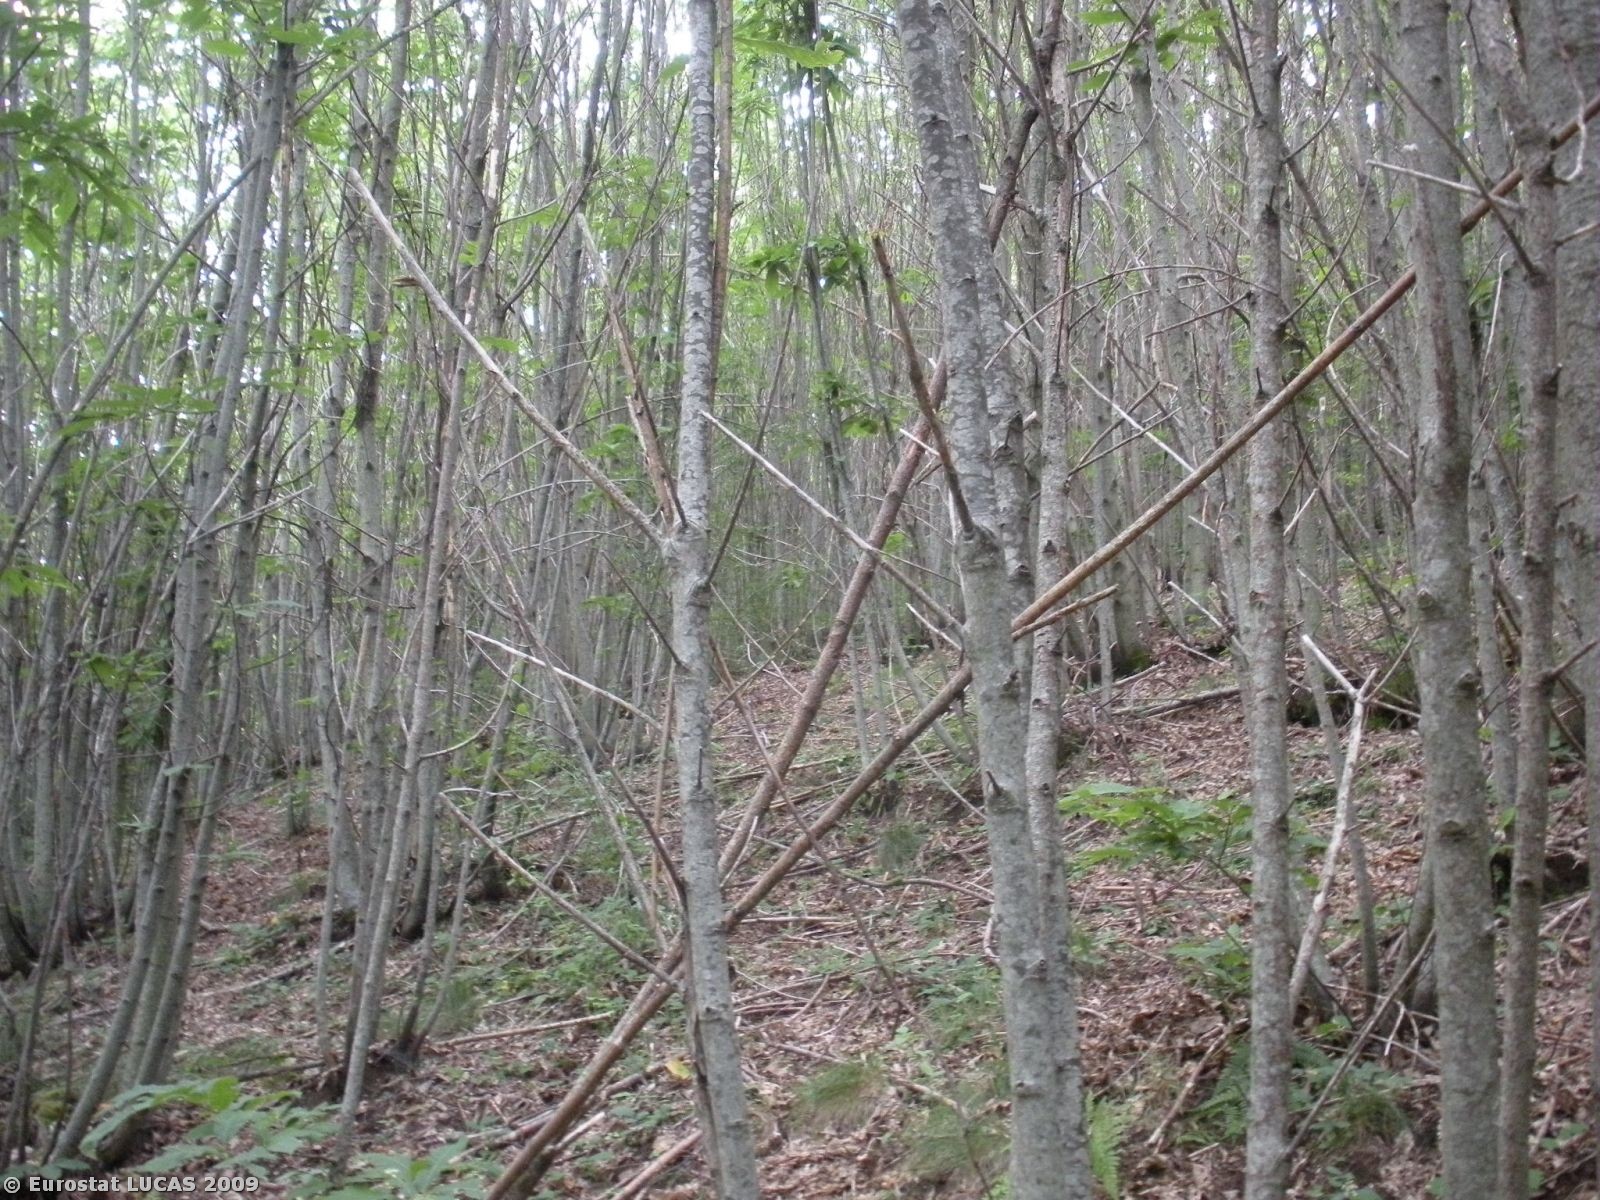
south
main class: Woodland
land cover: Broadleaved woodland
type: mesophytic deciduous forest
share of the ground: > 75 %
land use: Agriculture (excluding fallow land and kitchen gardens)
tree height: > 5 m
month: July
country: IT
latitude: 40.2451
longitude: 15.0675
